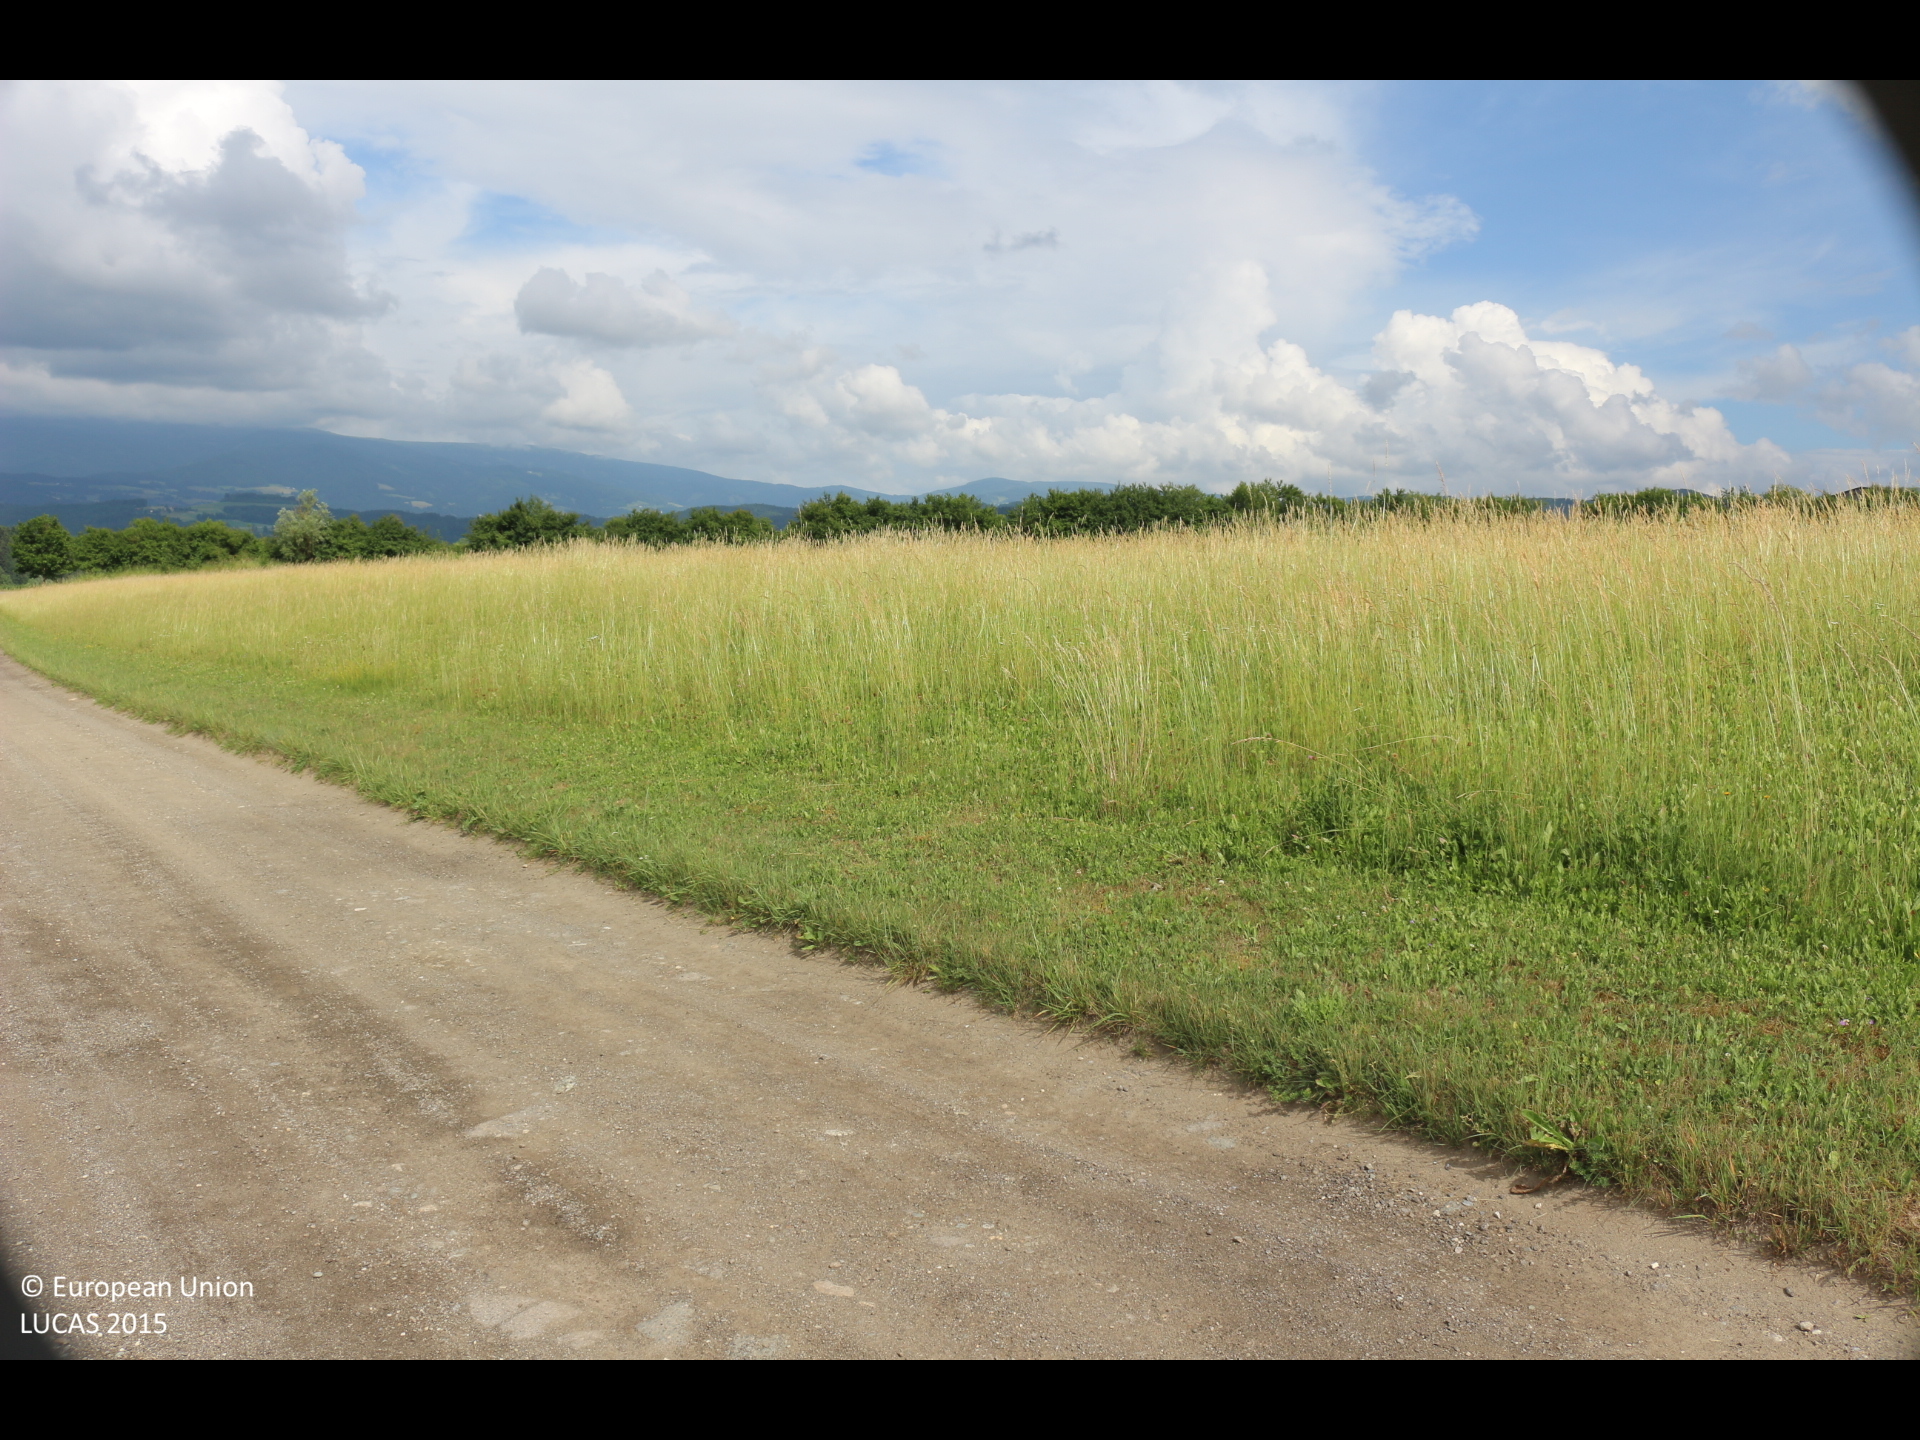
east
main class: Cropland
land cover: Common wheat
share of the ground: > 75 %
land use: Agriculture (excluding fallow land and kitchen gardens)
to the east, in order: Common wheat; Tracks; Grassland without tree/shrub cover; Other fresh vegetables; Barley; Spontaneously vegetated surfaces; Broadleaved woodland; Grass margins; Paved roads, cycling and walking lanes; Grass margins; Paved roads, cycling and walking lanes; Grass margins; Maize
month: June
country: AT
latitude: 46.8361
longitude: 14.4426
